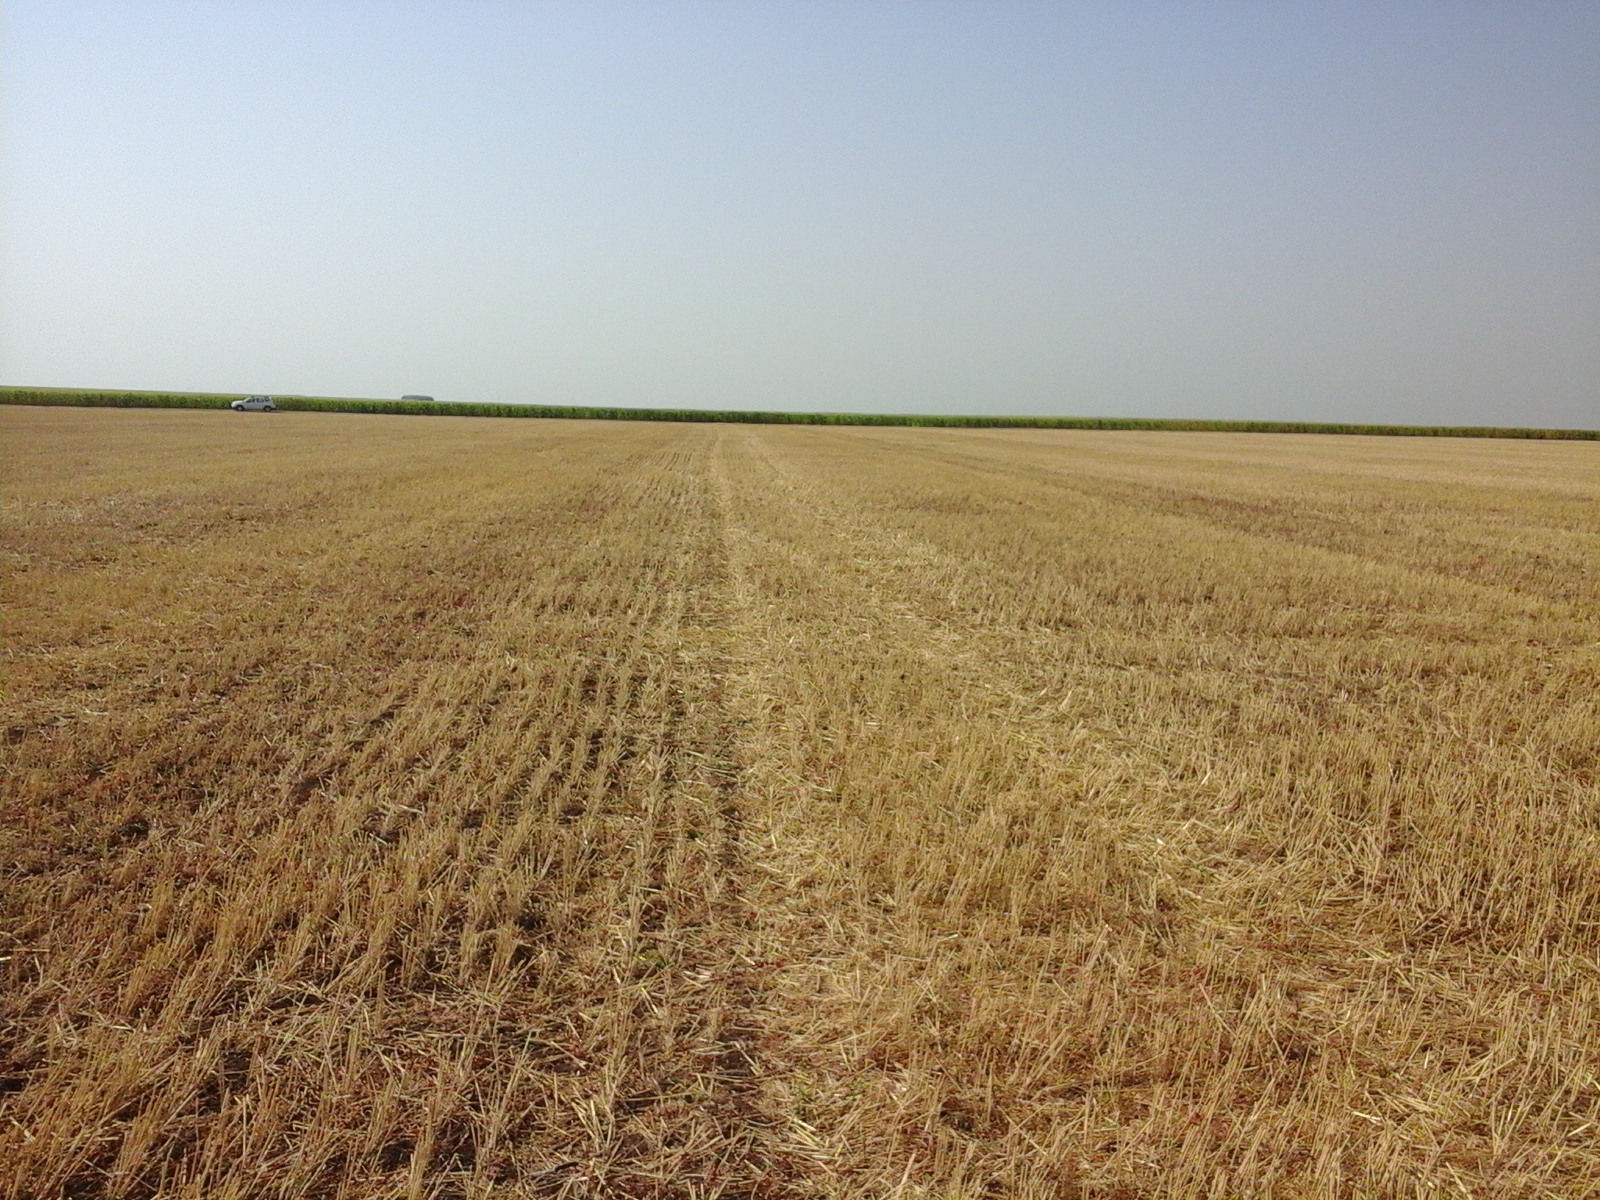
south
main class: Cropland
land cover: Common wheat
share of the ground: > 75 %
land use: Agriculture (excluding fallow land and kitchen gardens)
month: August
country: RO
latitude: 45.7817
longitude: 27.5868
